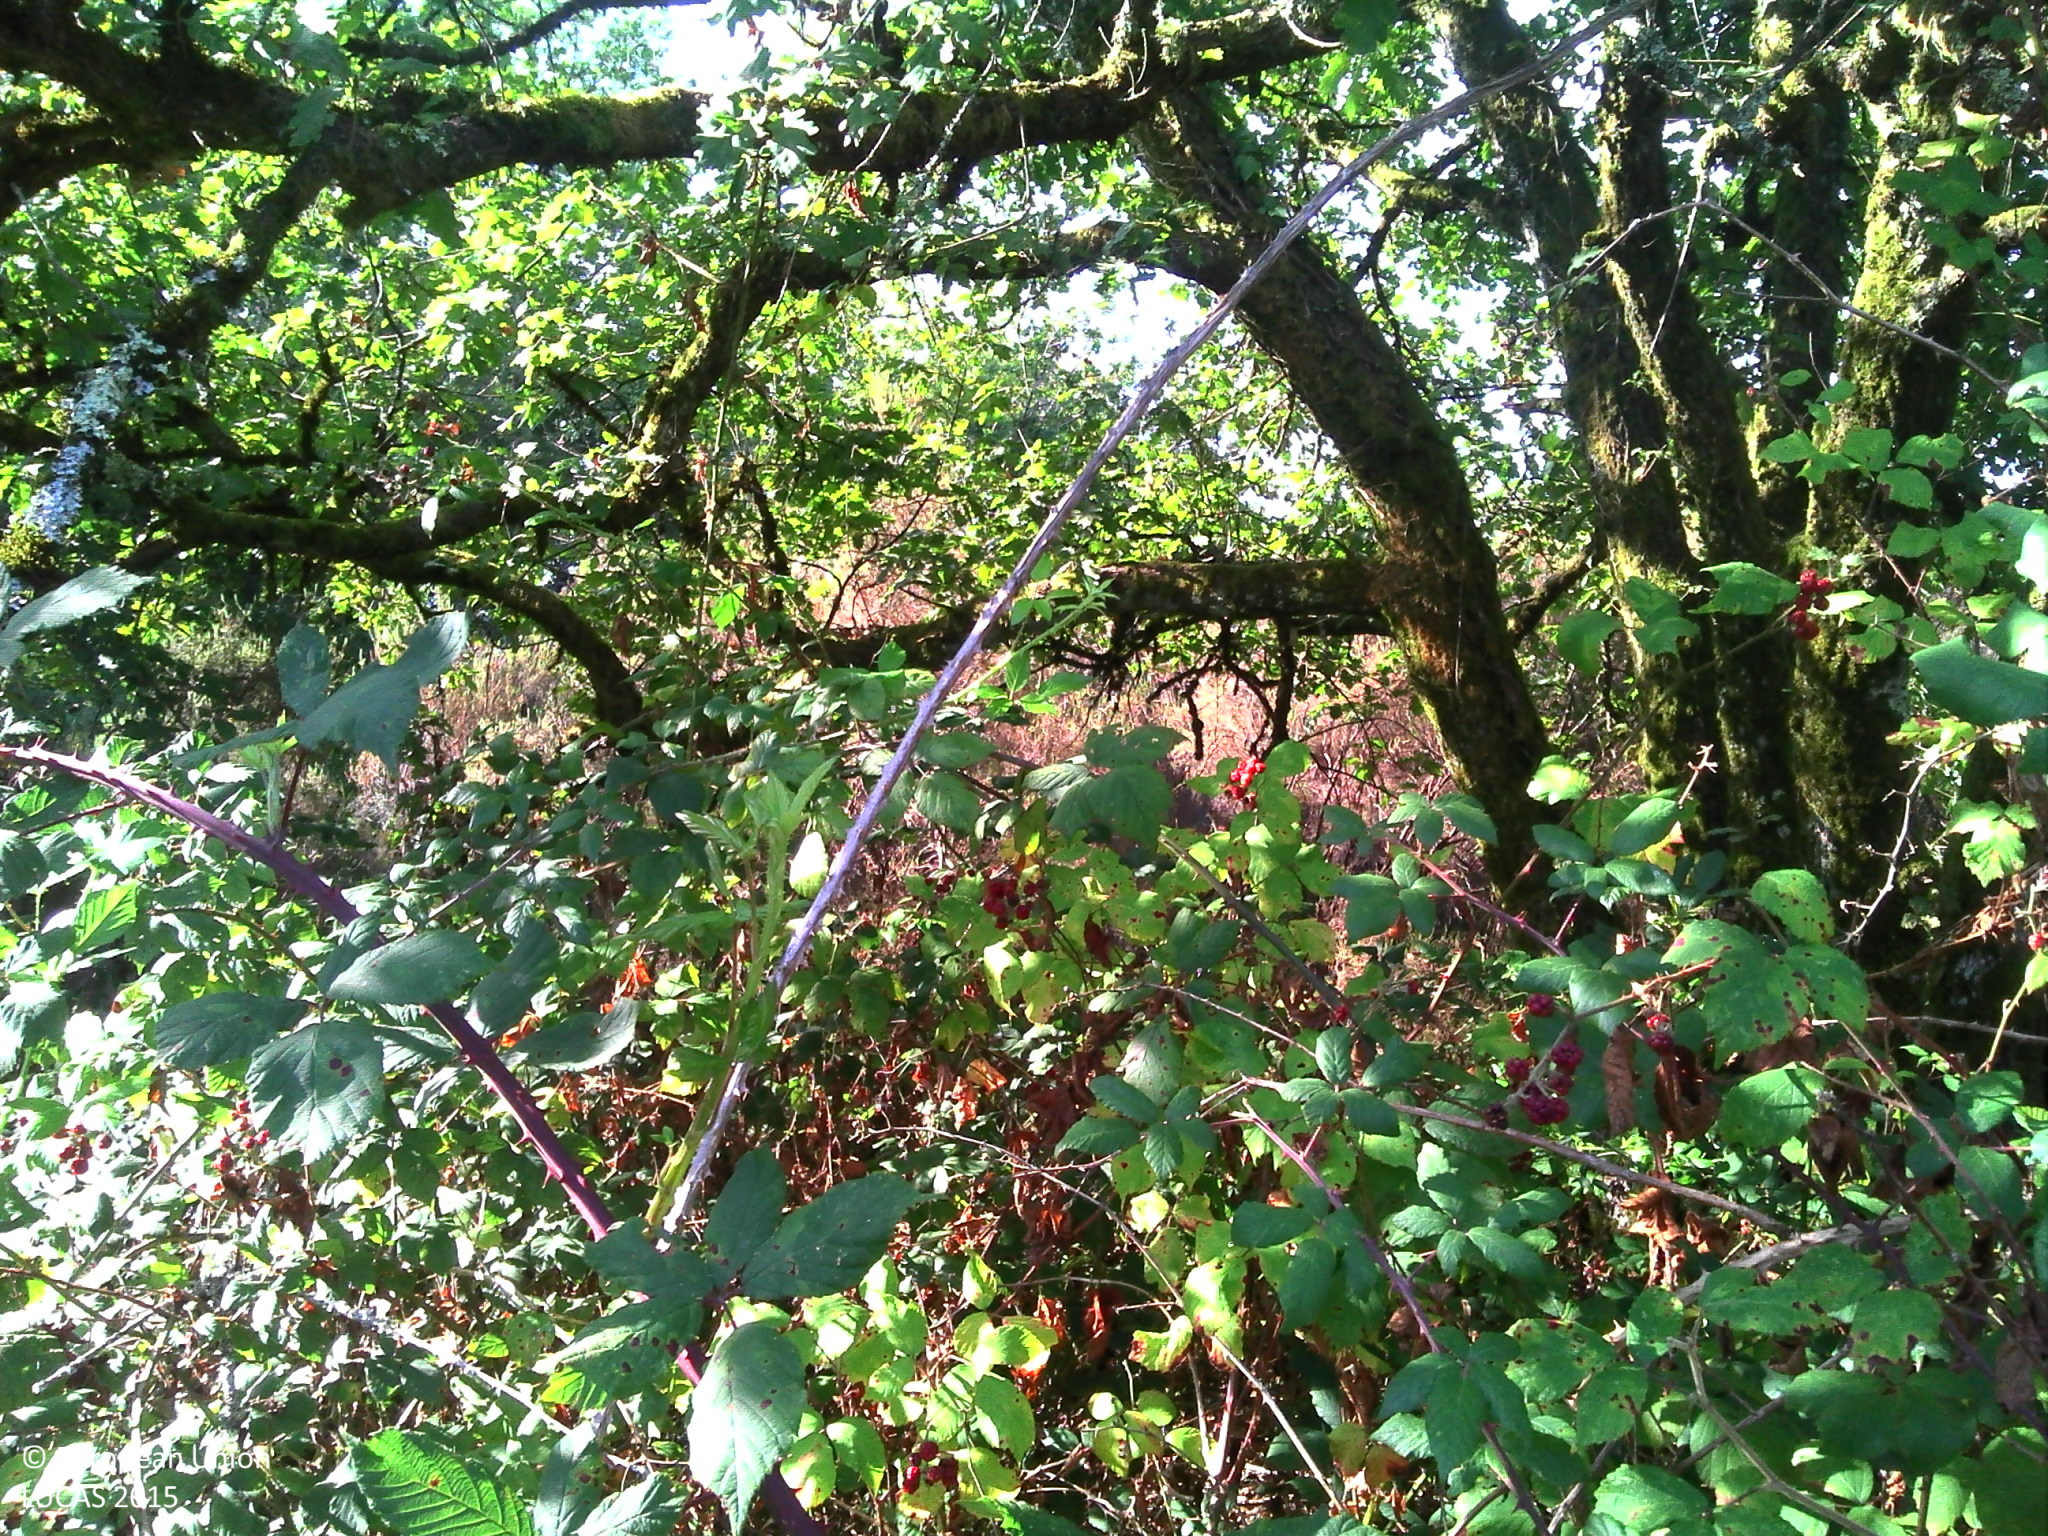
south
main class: Grassland
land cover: Spontaneously vegetated surfaces
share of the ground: > 75 %
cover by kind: herbaceous plants 60 %, unconsolidated bare surface 25 %, lichens and mosses 10 %, shrubs 5 %
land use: Semi-natural and natural areas not in use
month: August
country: FR
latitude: 45.4149
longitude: 0.6475
